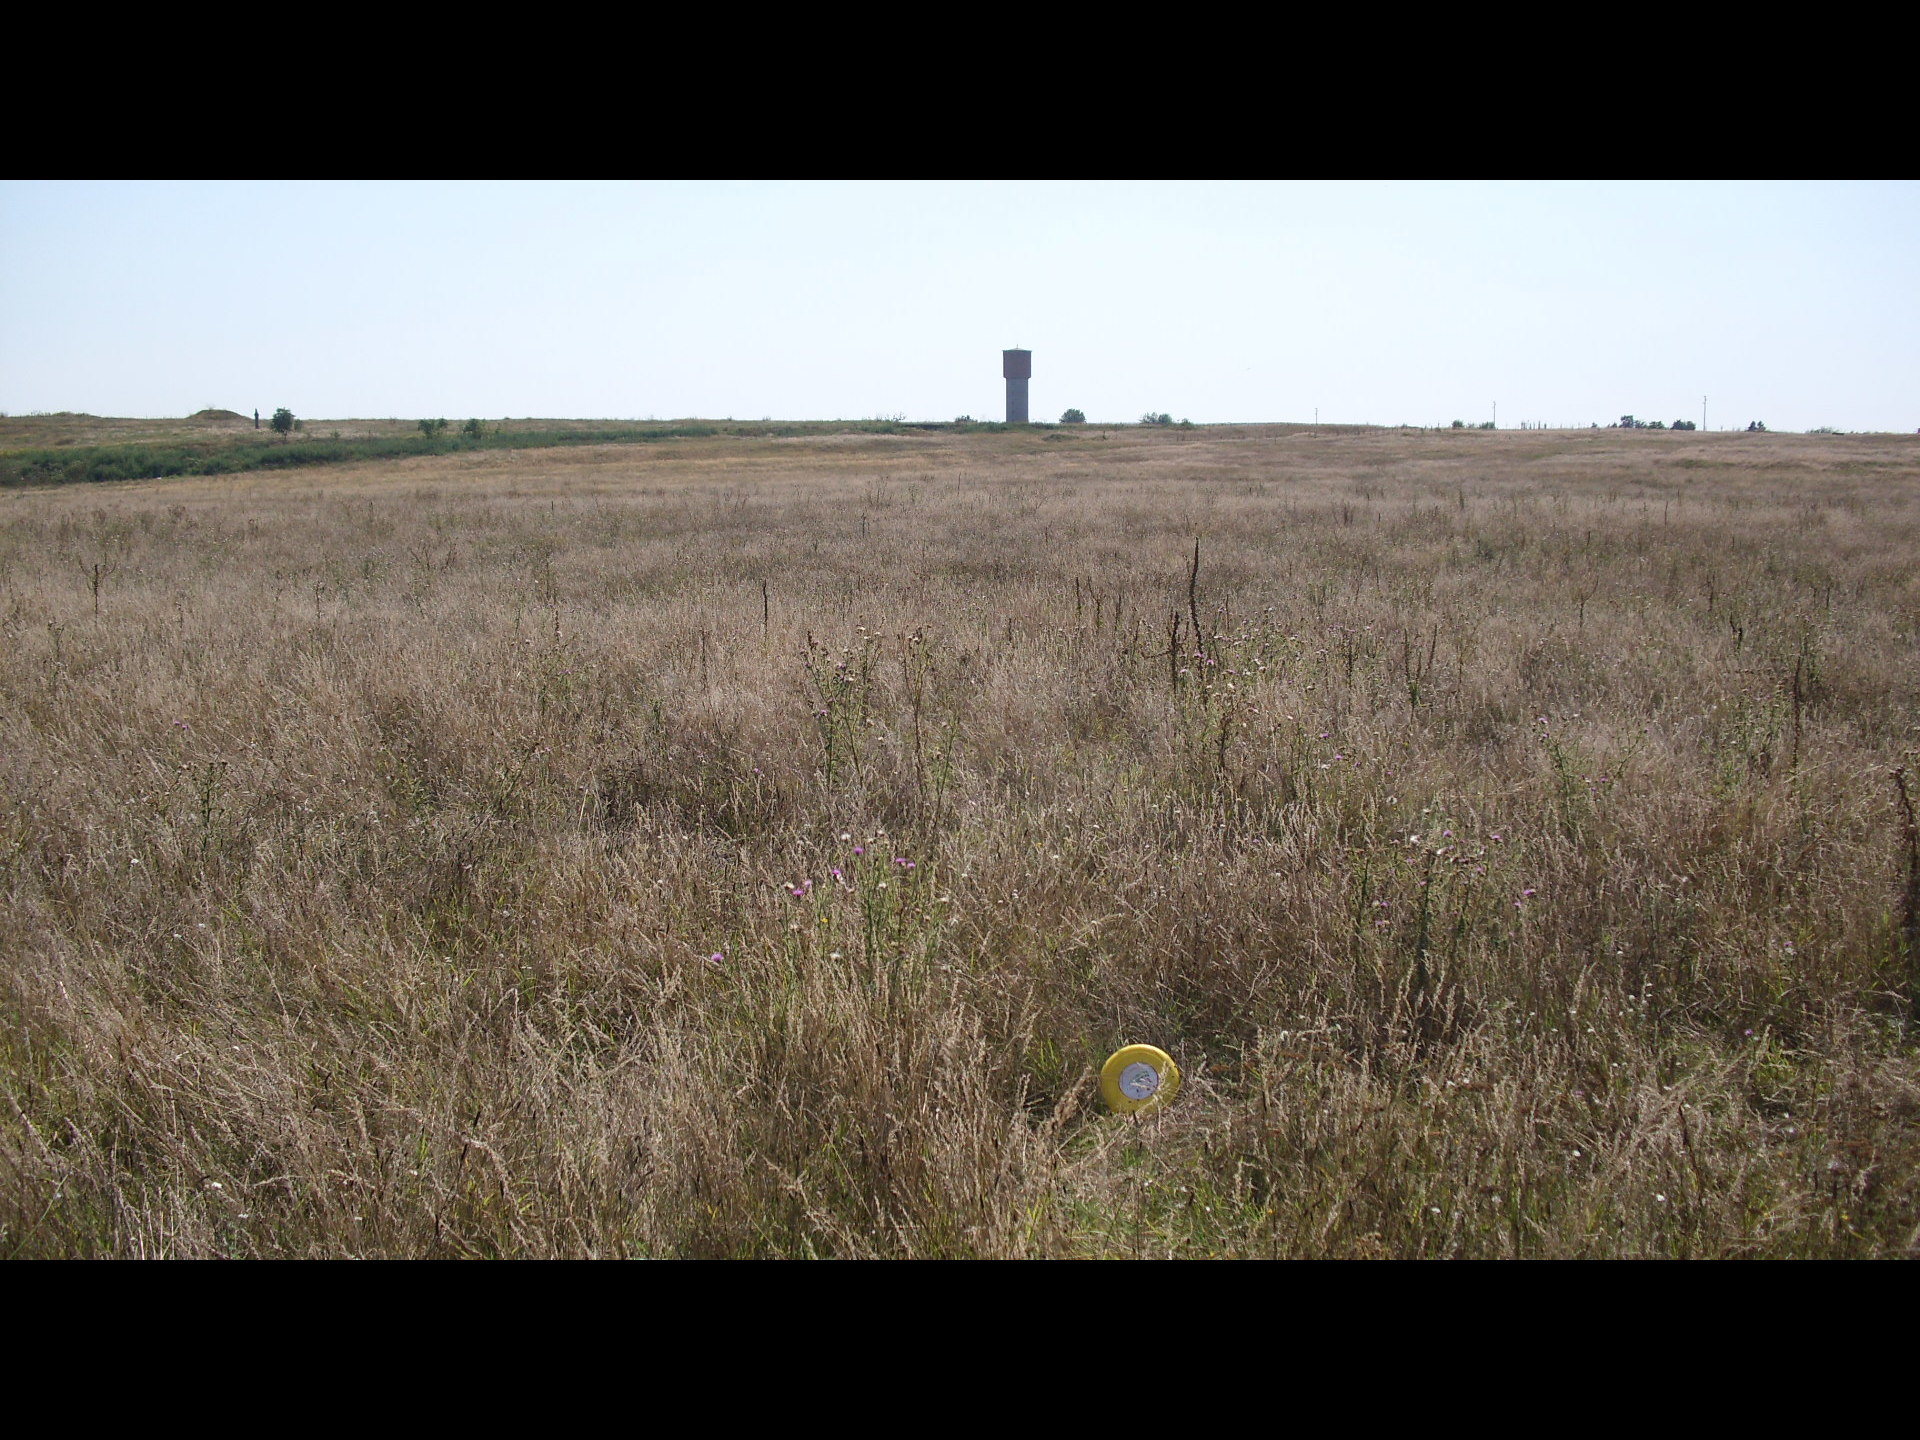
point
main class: Grassland
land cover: Grassland without tree/shrub cover
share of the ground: > 75 %
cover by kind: herbaceous plants 100 %
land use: Agriculture (excluding fallow land and kitchen gardens)
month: August
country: BG
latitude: 44.1561
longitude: 22.6540
